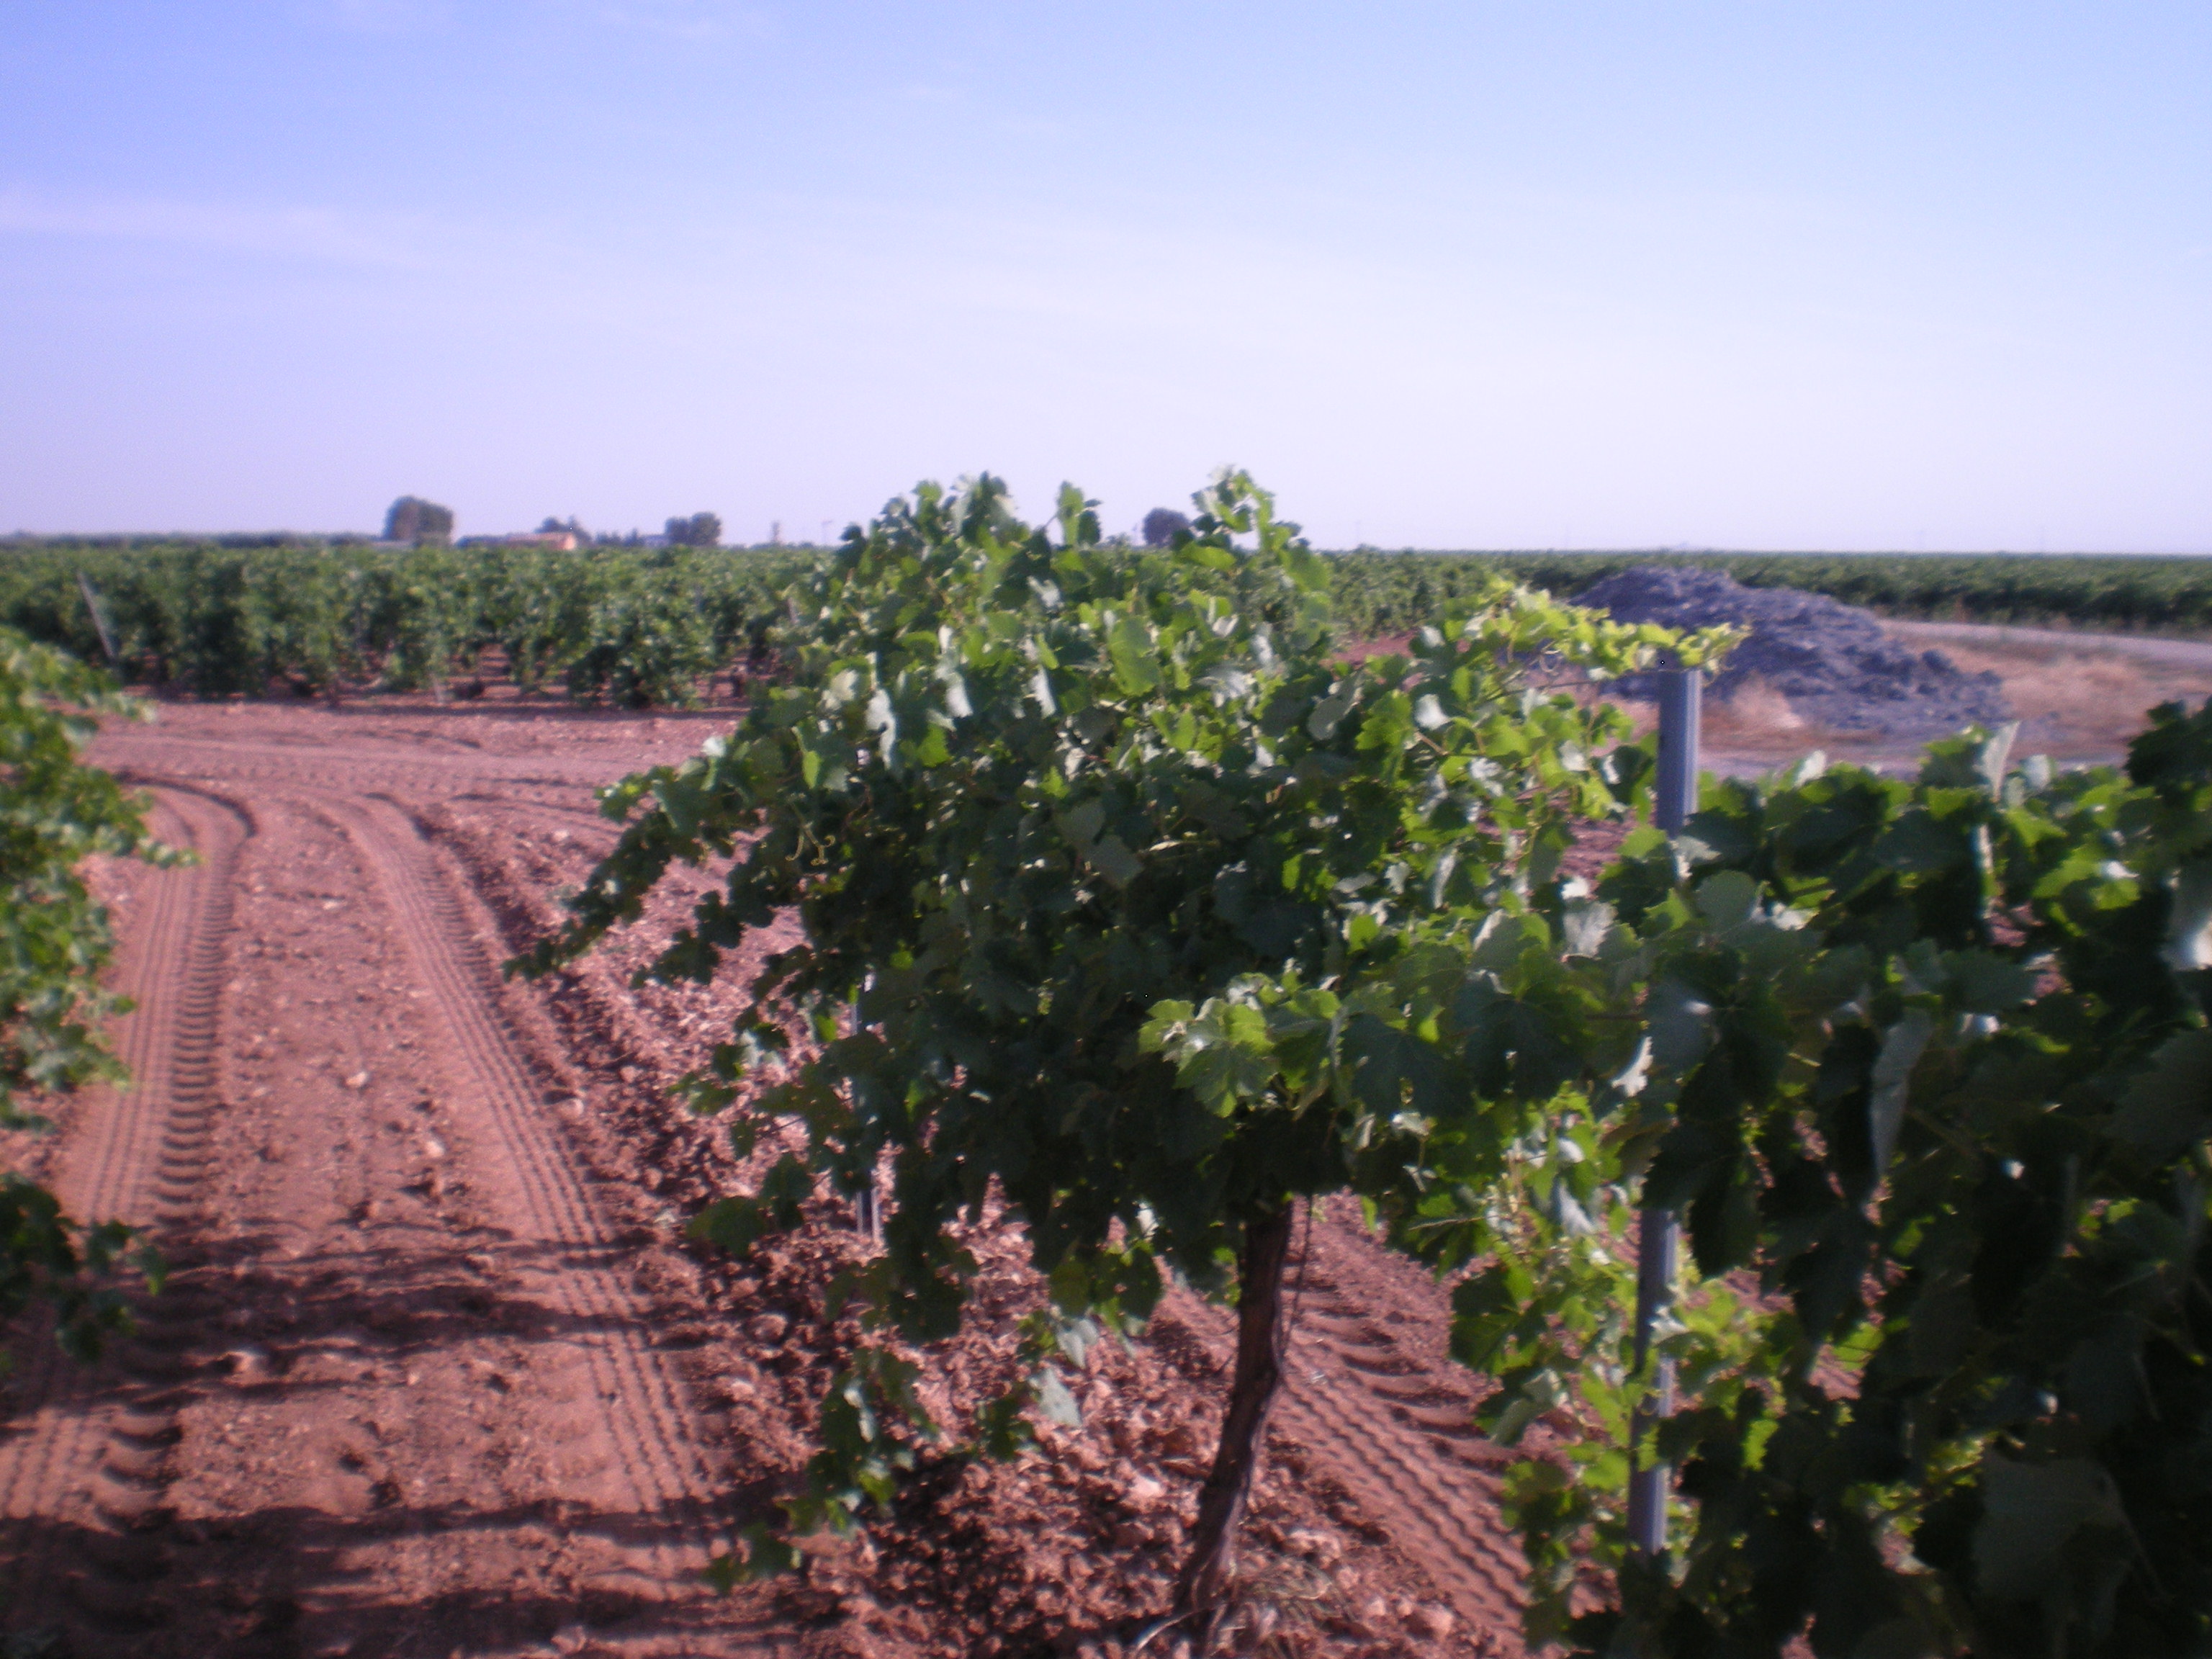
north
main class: Cropland
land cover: Vineyards
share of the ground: 10 - 25 %
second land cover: Other bare soil
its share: > 75 %
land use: Agriculture (excluding fallow land and kitchen gardens)
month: July
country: ES
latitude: 39.3940
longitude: -3.0323
